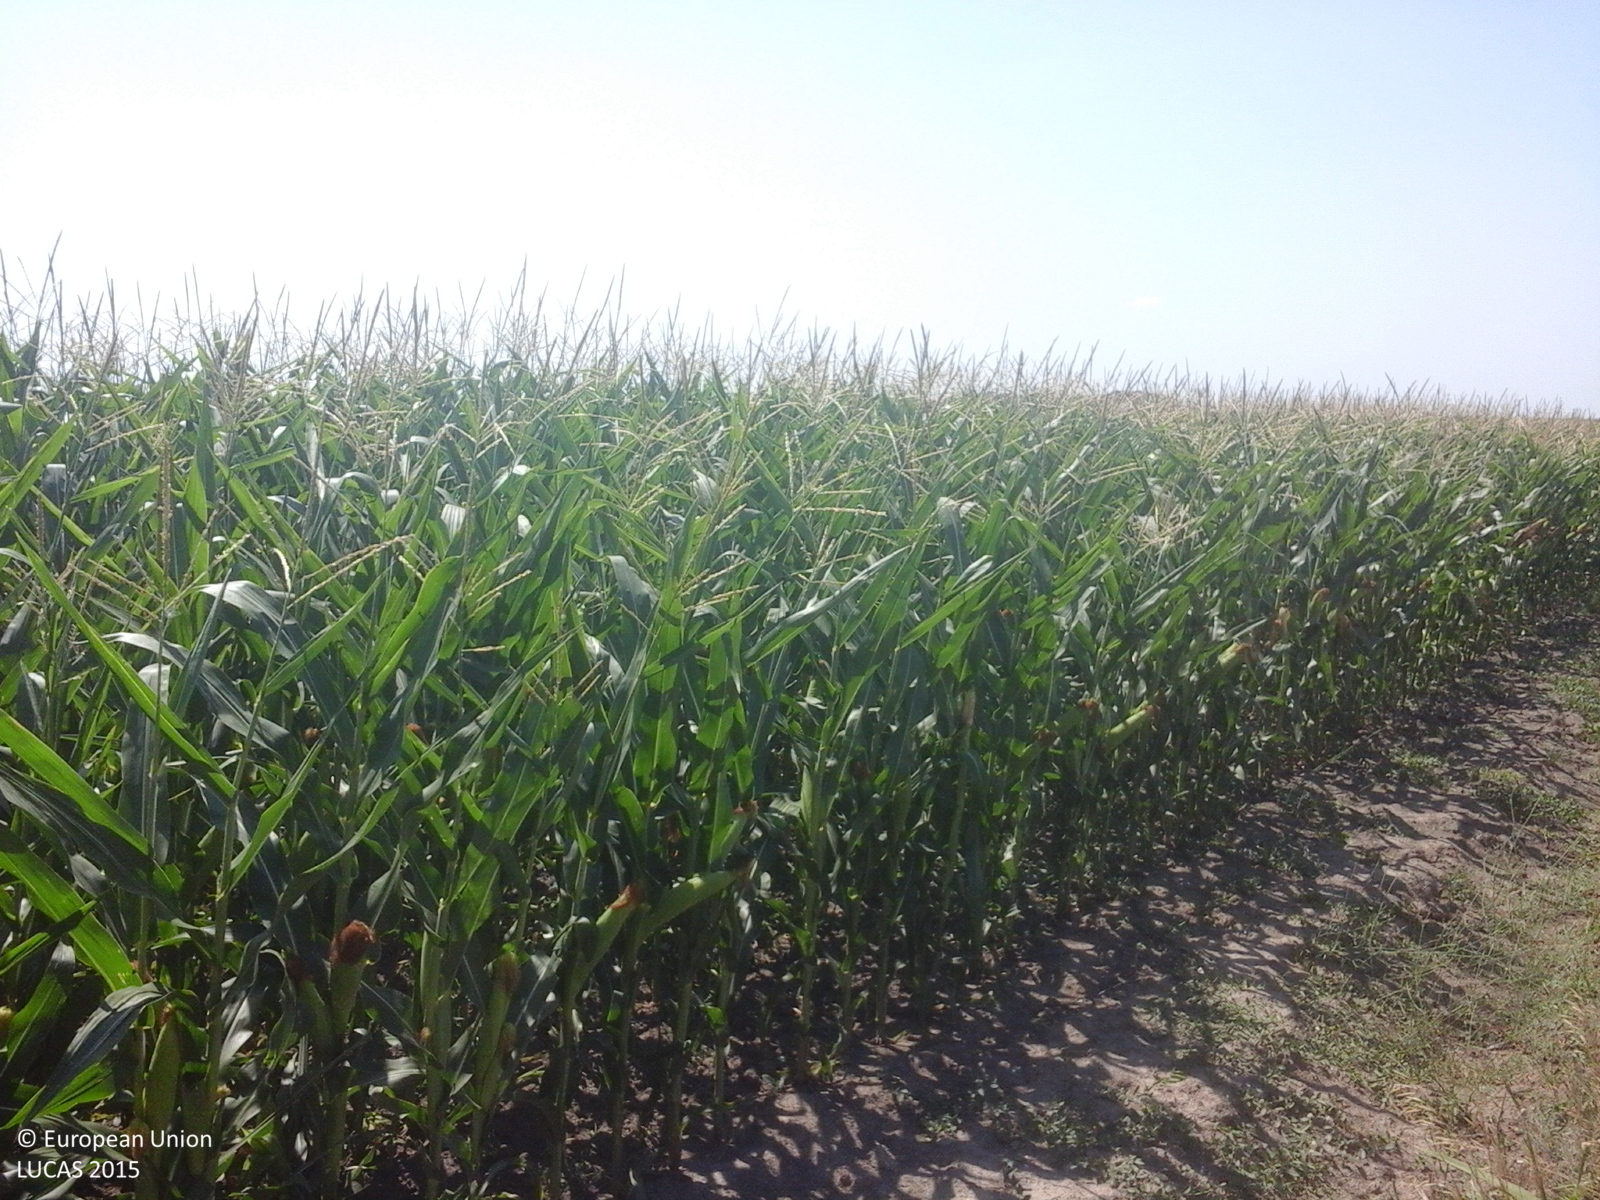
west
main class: Cropland
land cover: Maize
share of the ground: > 75 %
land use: Agriculture (excluding fallow land and kitchen gardens)
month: July
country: RO
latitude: 44.9393
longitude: 26.8964
